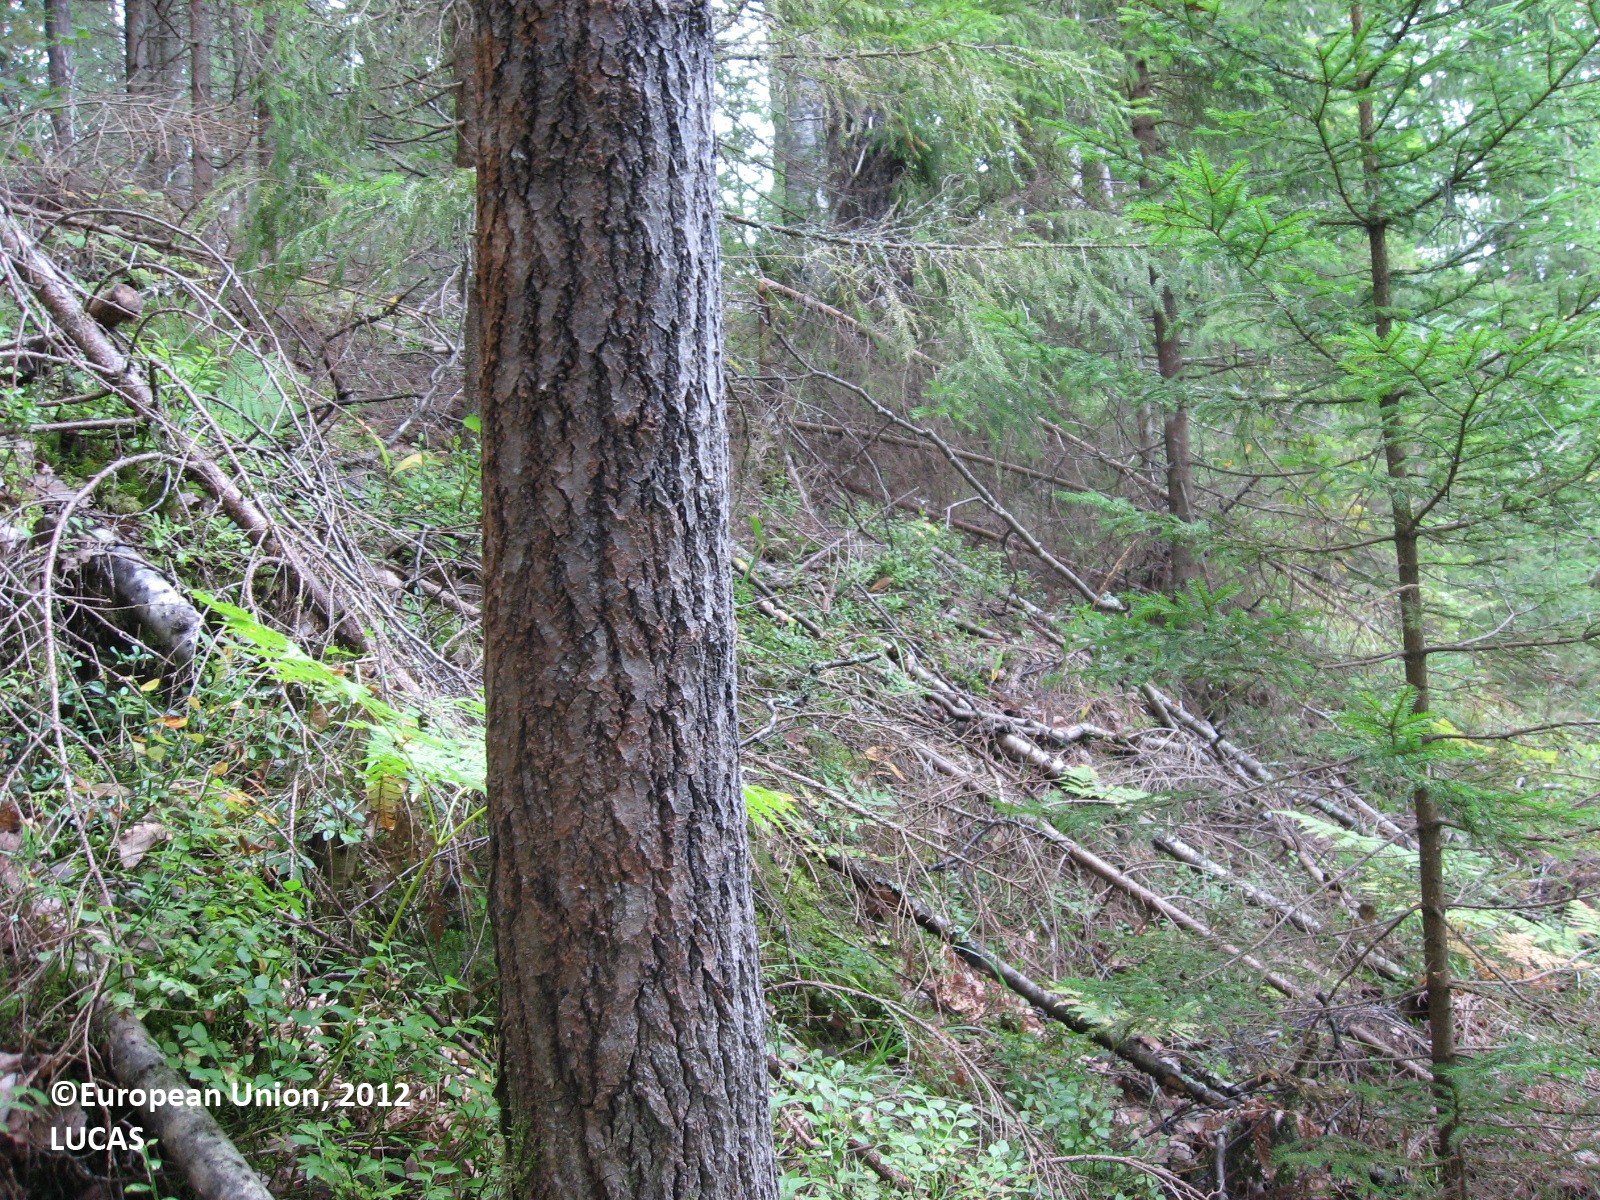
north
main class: Woodland
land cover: Spruce dominated mixed woodland
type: boreal forest
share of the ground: > 75 %
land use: Forestry
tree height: > 5 m
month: August
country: FI
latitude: 60.9108
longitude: 25.5612
